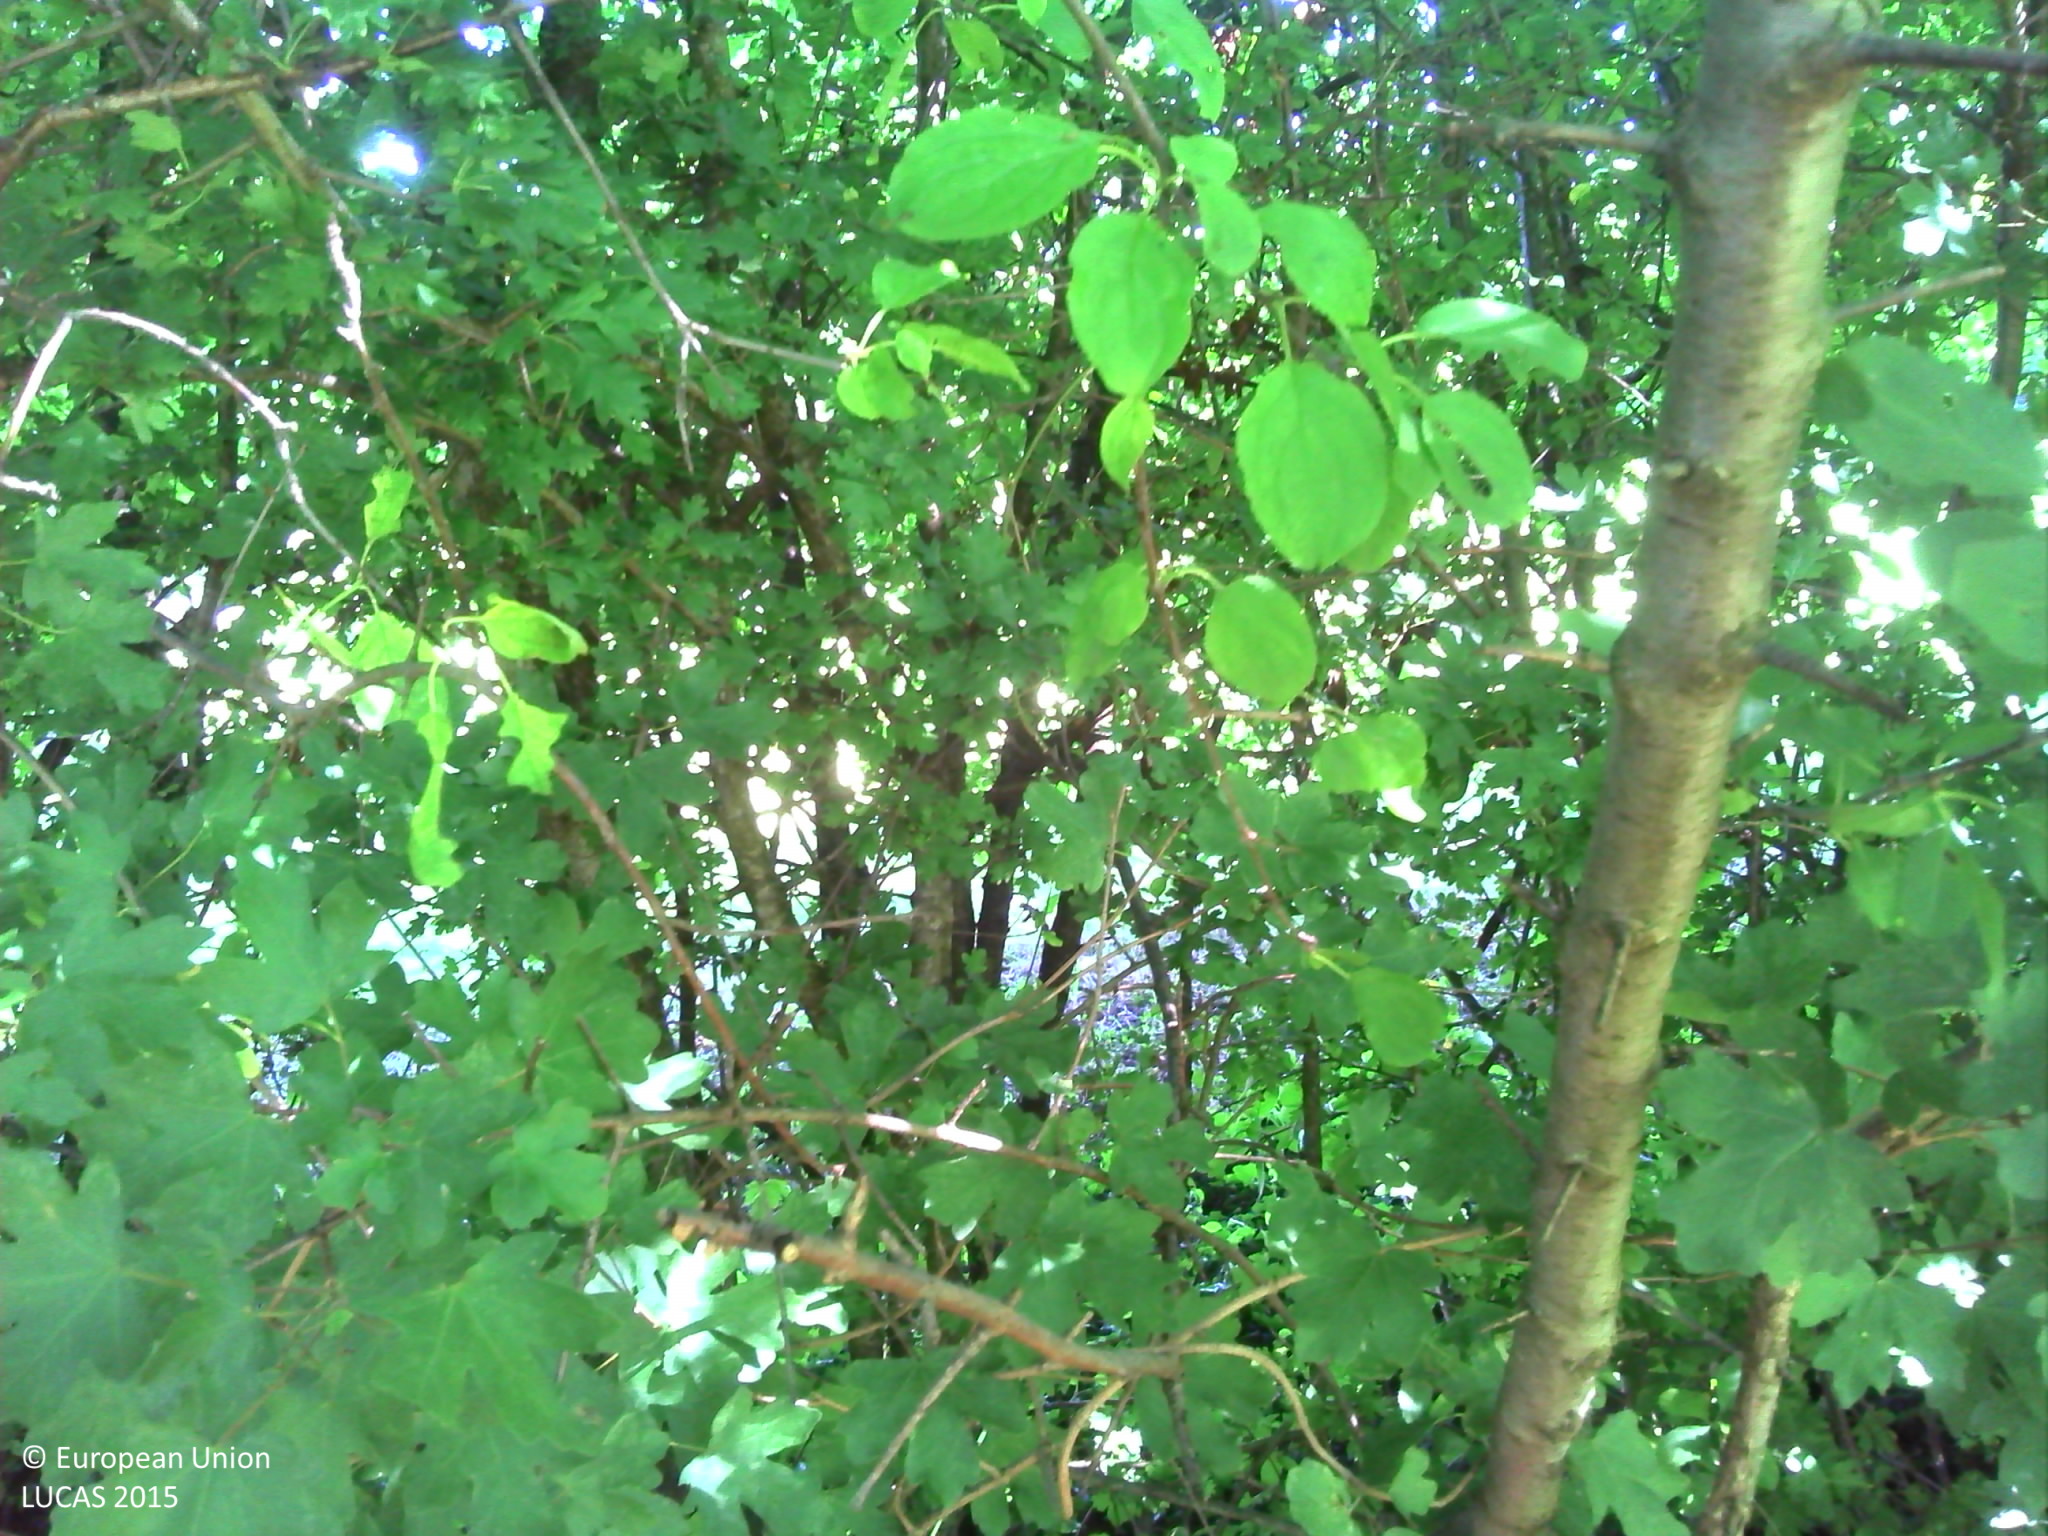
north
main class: Grassland
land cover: Grassland with sparse tree/shrub cover
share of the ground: > 75 %
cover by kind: herbaceous plants 95 %, broadleaved forest trees 5 %
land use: Residential
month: June
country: FR
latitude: 46.5409
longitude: 5.3993
